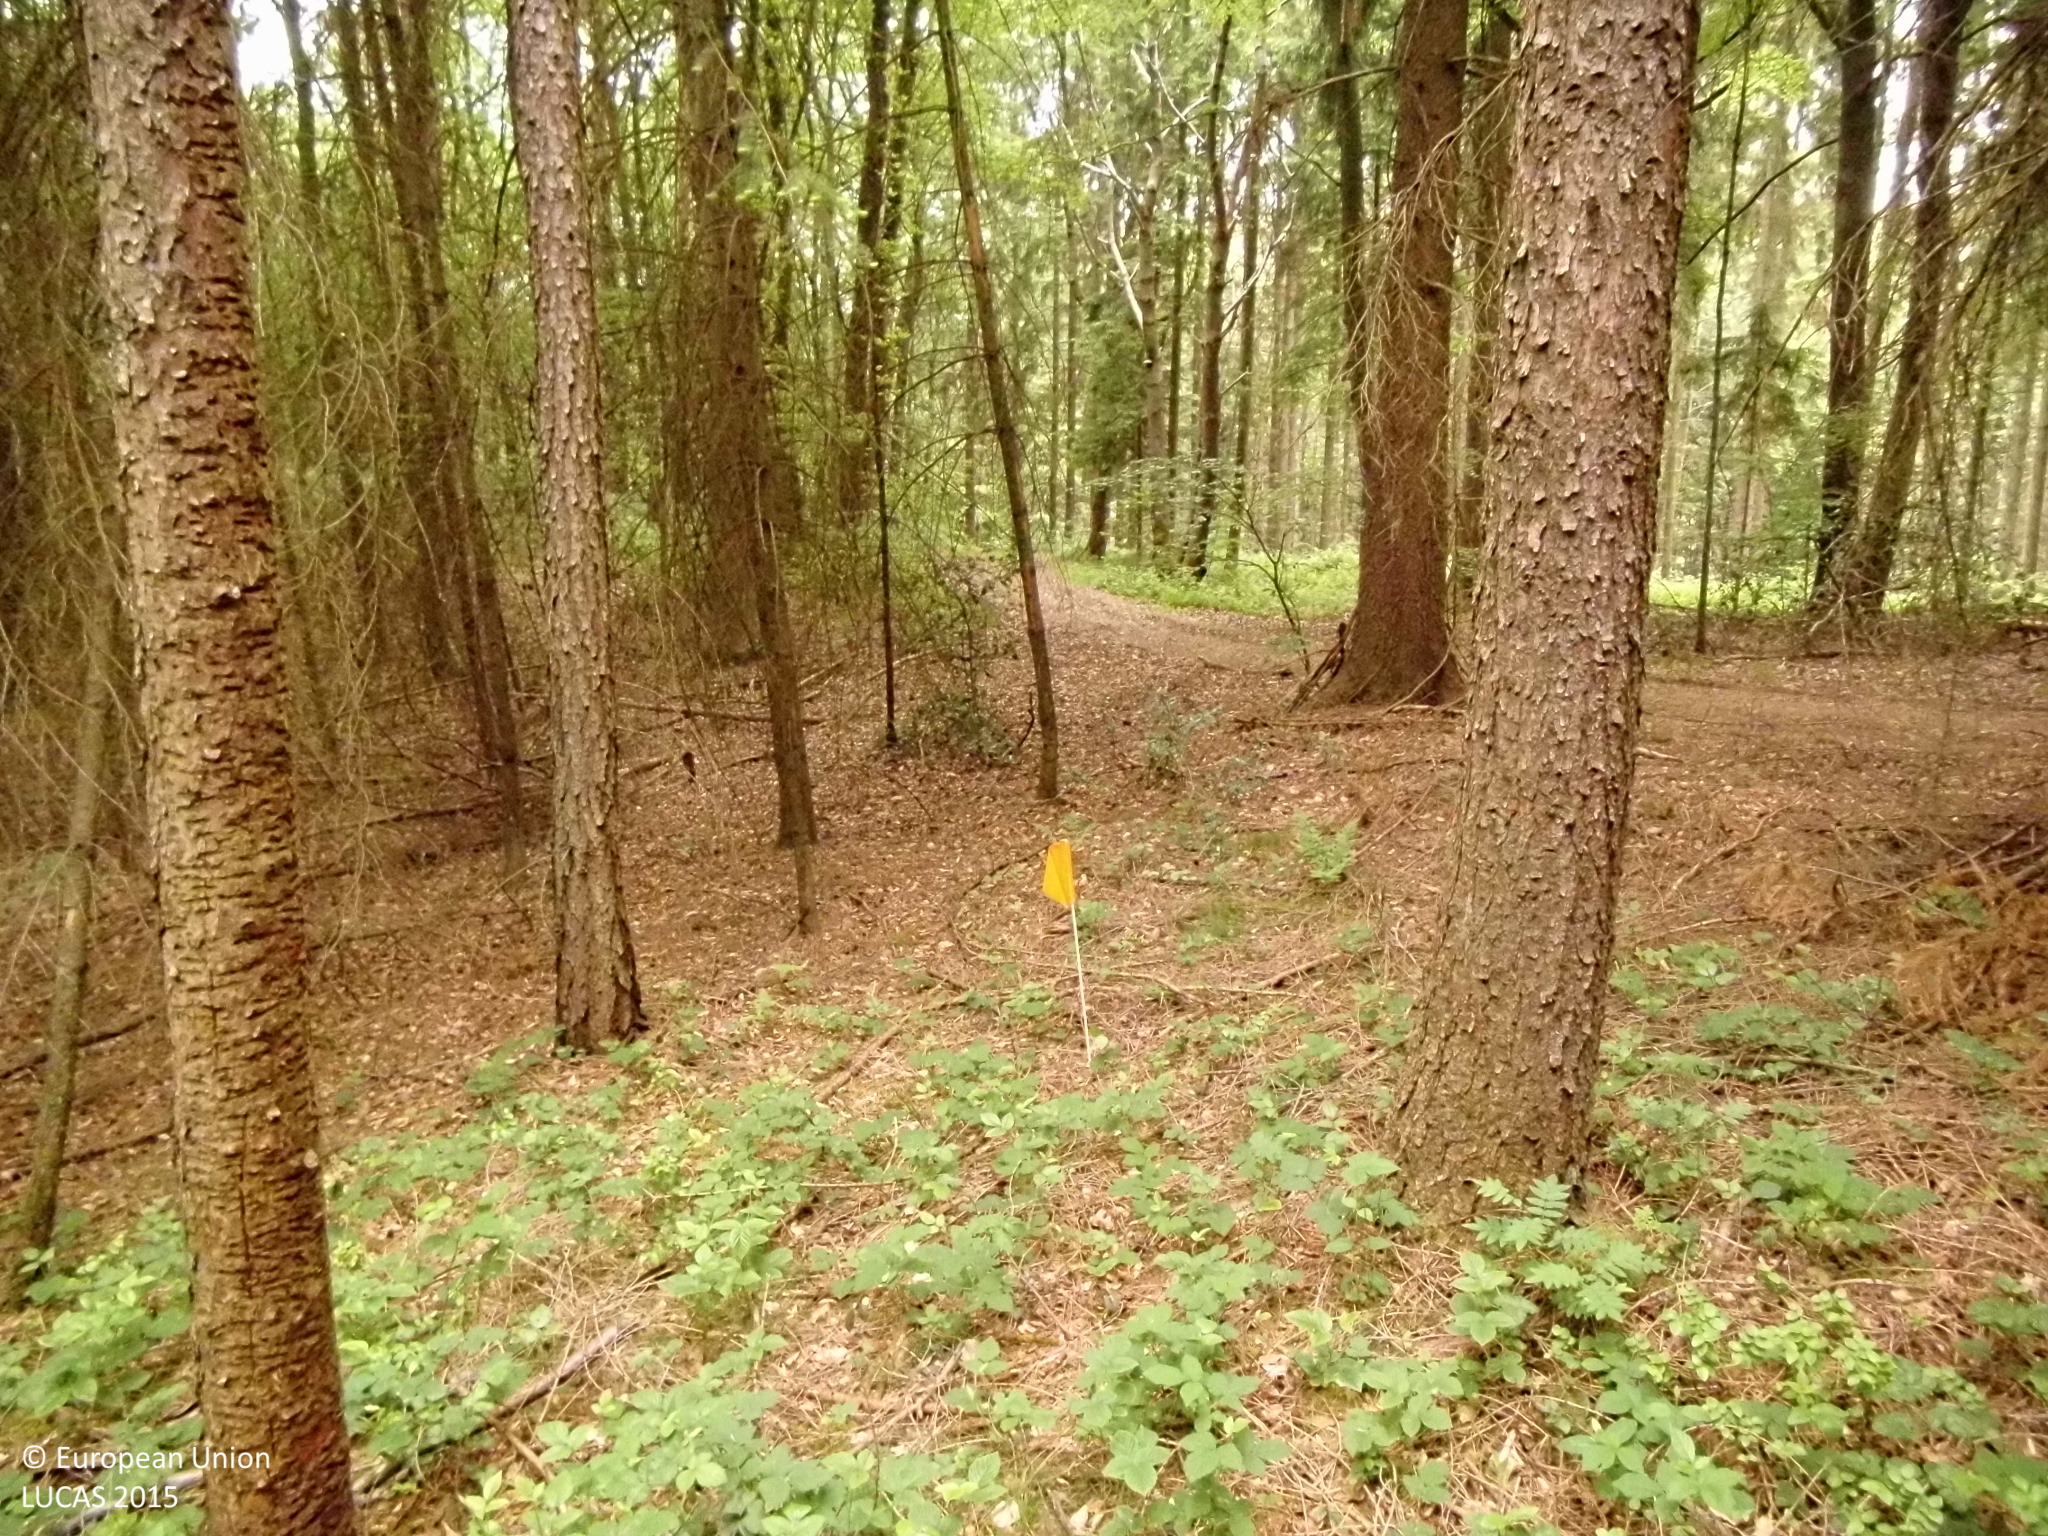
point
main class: Woodland
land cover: Other mixed woodland
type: hemiboreal forest and nemoral coniferous forest and mixed broadleaved-coniferous forest
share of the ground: > 75 %
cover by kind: coniferous forest trees 60 %, broadleaved forest trees 25 %, herbaceous plants 10 %, lichens and mosses 5 %
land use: Forestry
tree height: > 5 m
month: May
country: DE
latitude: 50.7503
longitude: 7.4915
